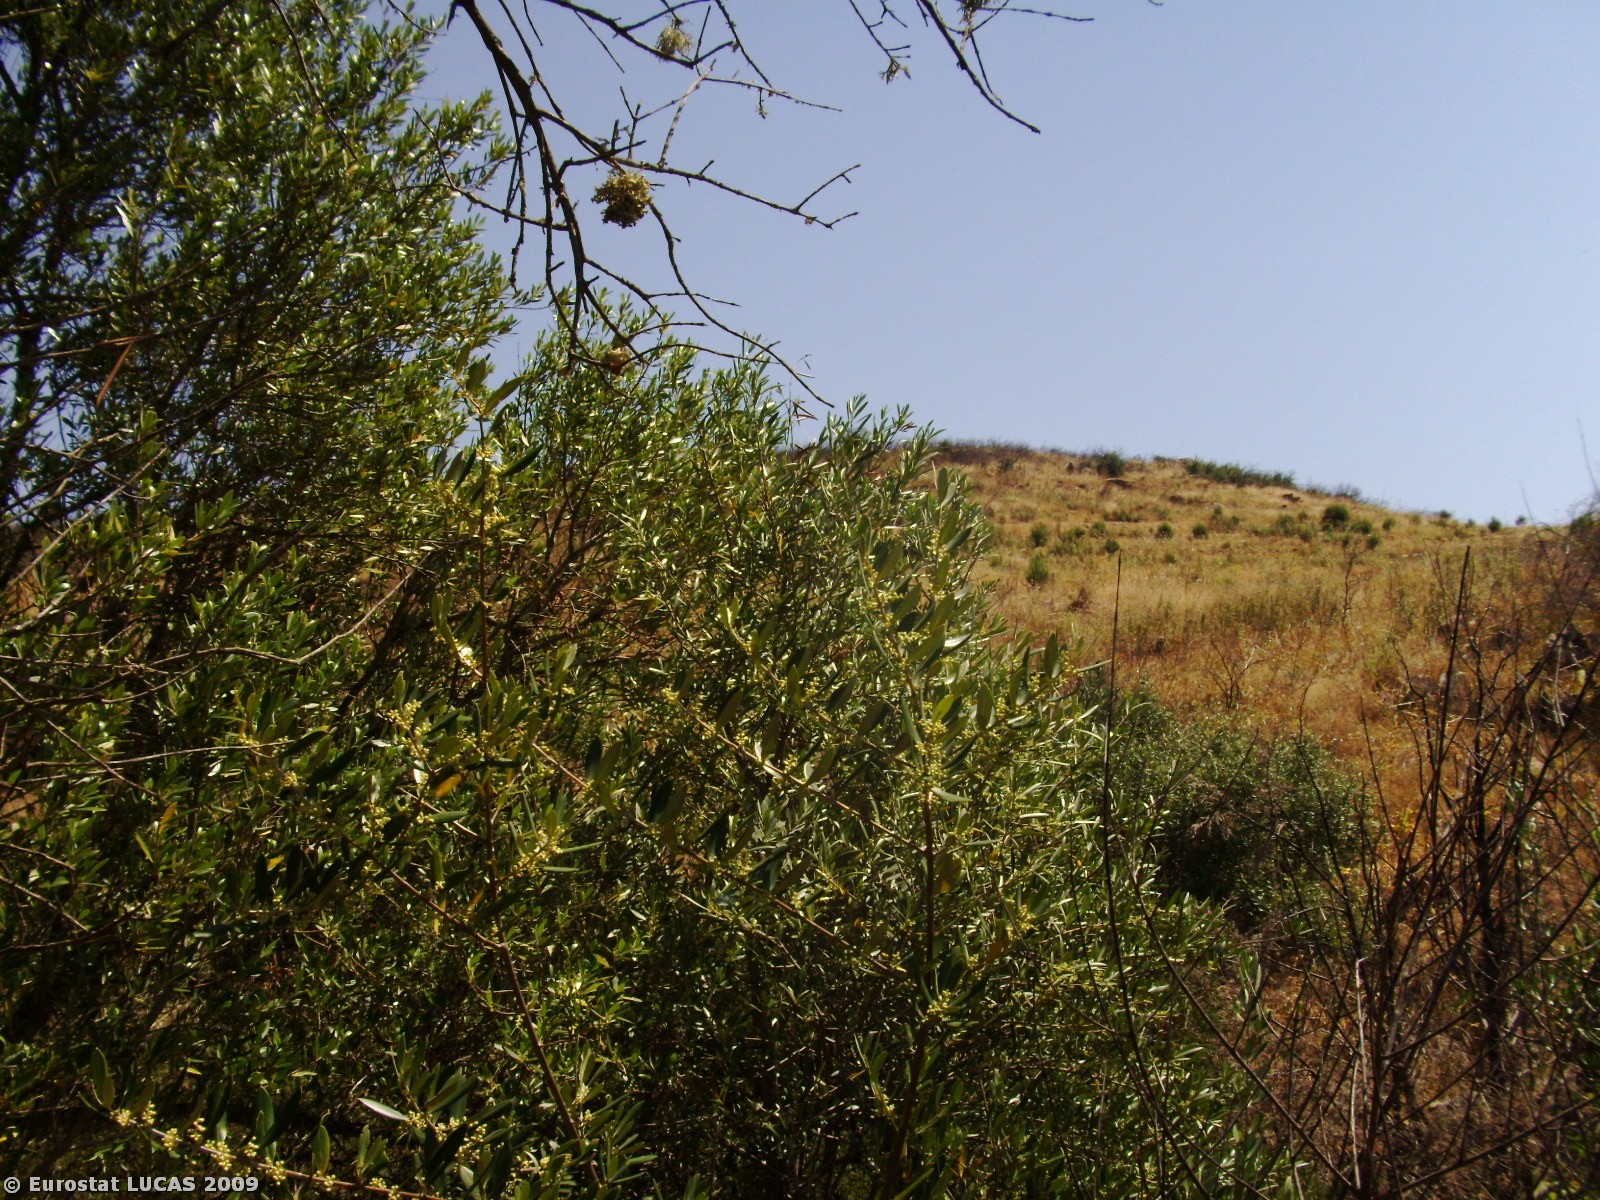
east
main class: Cropland
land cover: Olive groves
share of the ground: 25 - 50 %
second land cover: Spontaneously vegetated surfaces
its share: > 75 %
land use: Fallow land
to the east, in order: Olive groves; Spontaneously vegetated surfaces; Rivers and streams; Tracks; Shrubland without tree cover
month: May
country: PT
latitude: 37.5155
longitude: -7.6049
